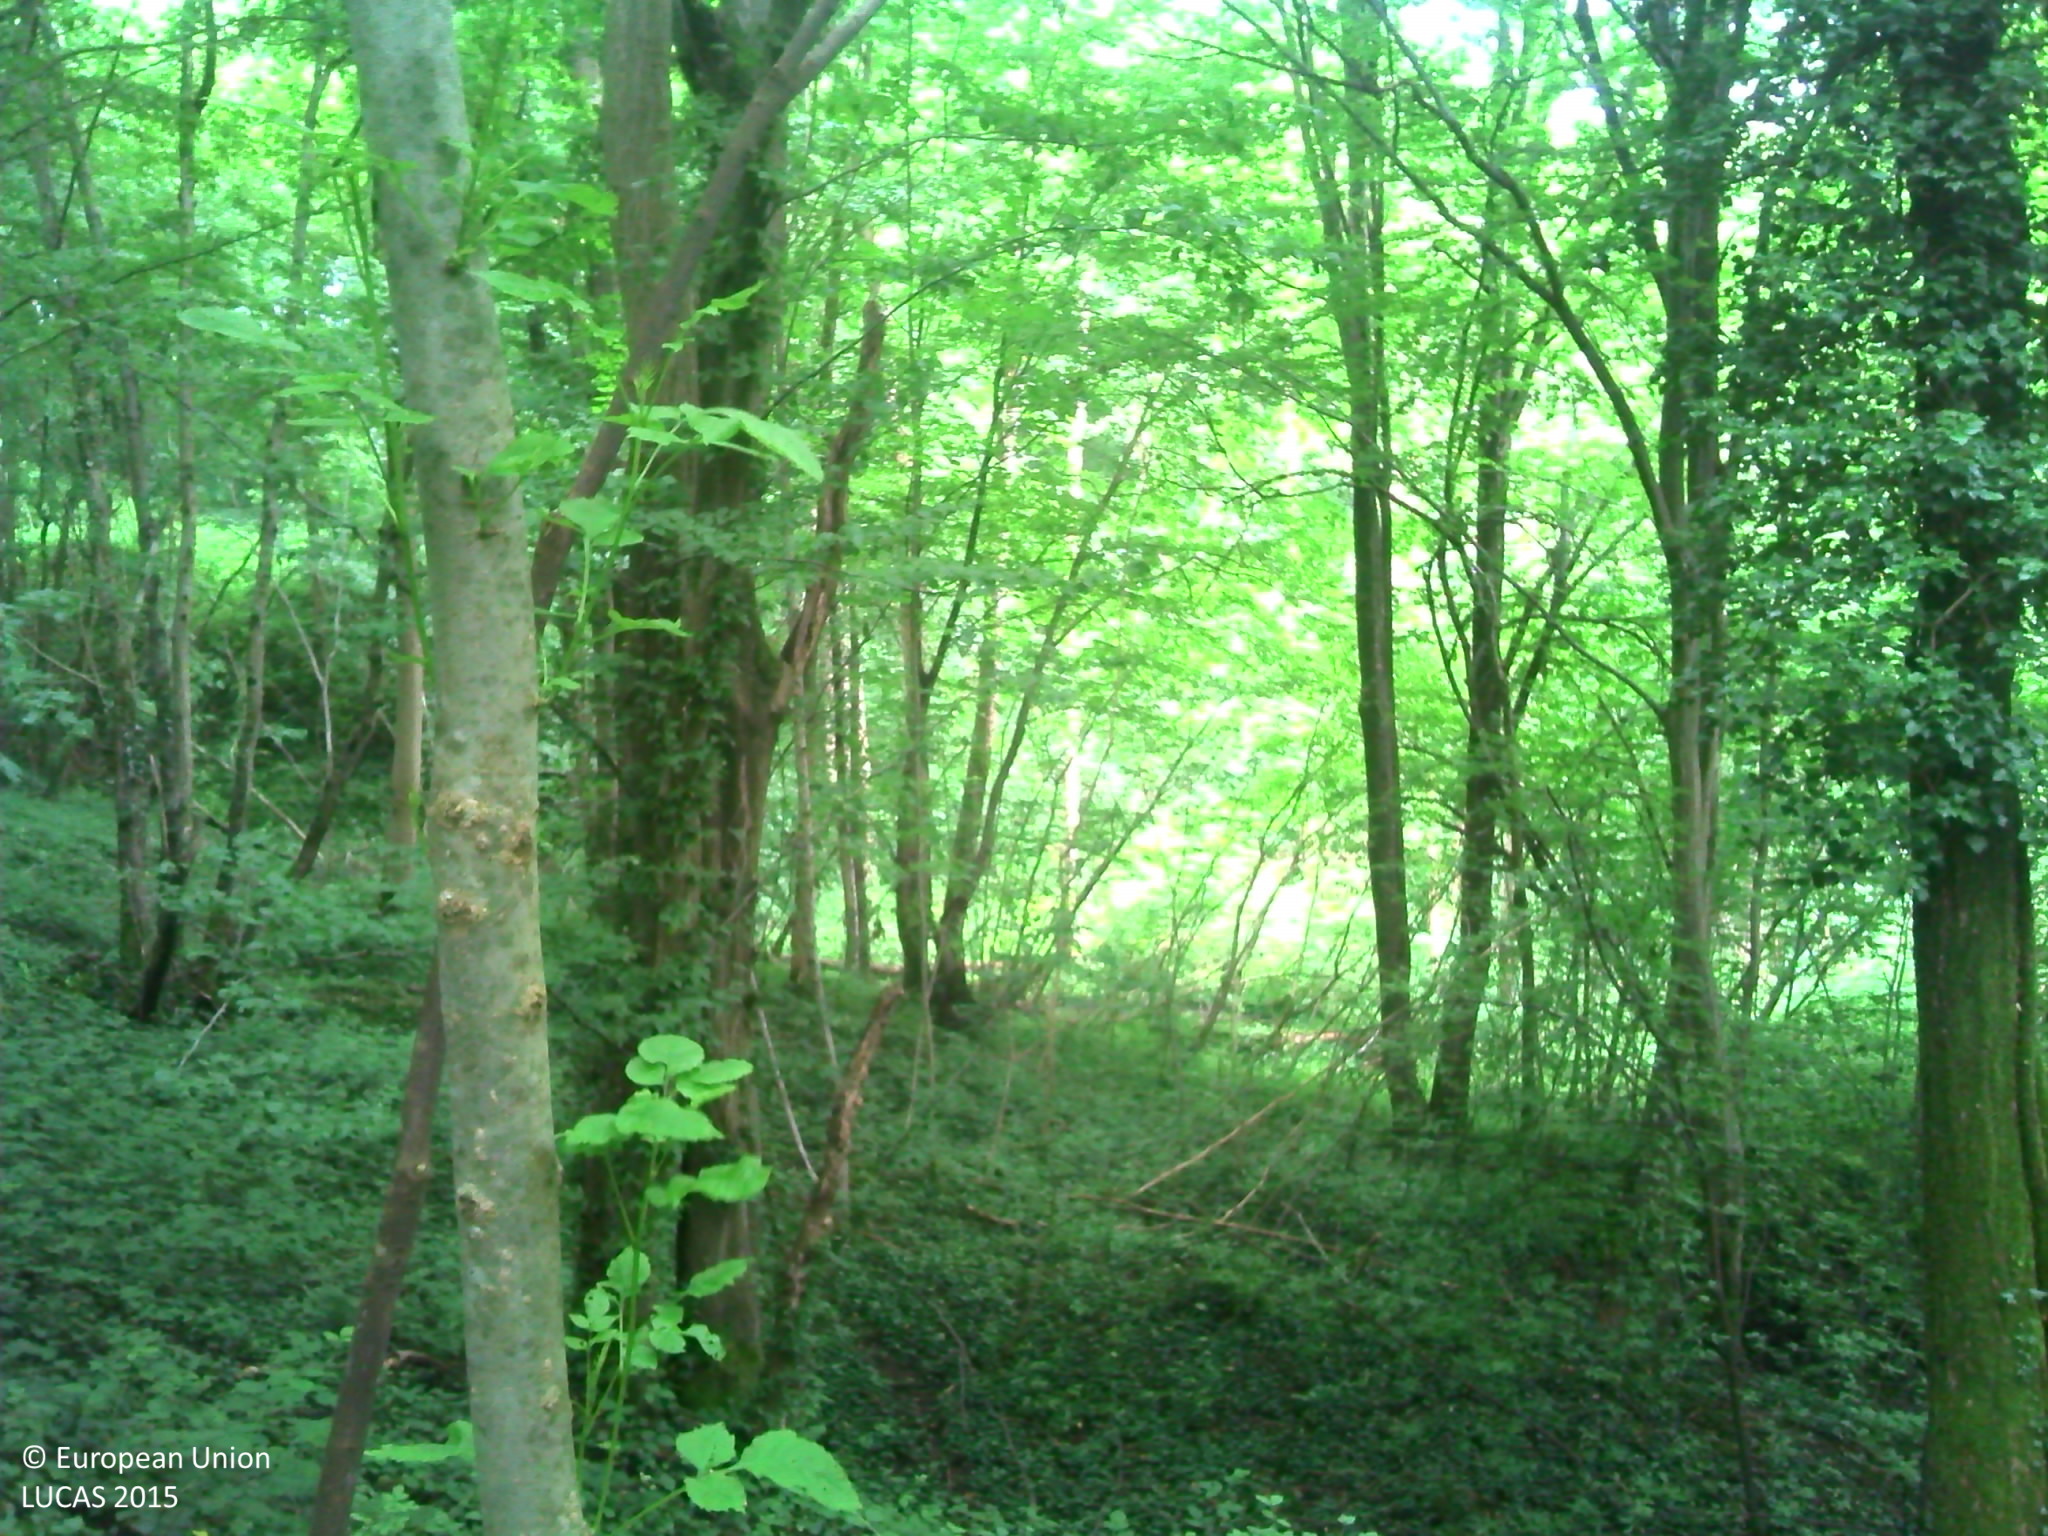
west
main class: Woodland
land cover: Broadleaved woodland
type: mesophytic deciduous forest
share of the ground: > 75 %
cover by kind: broadleaved forest trees 85 %, shrubs 10 %, herbaceous plants 5 %
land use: Forestry
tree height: > 5 m
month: June
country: FR
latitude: 49.5040
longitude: 3.6828
